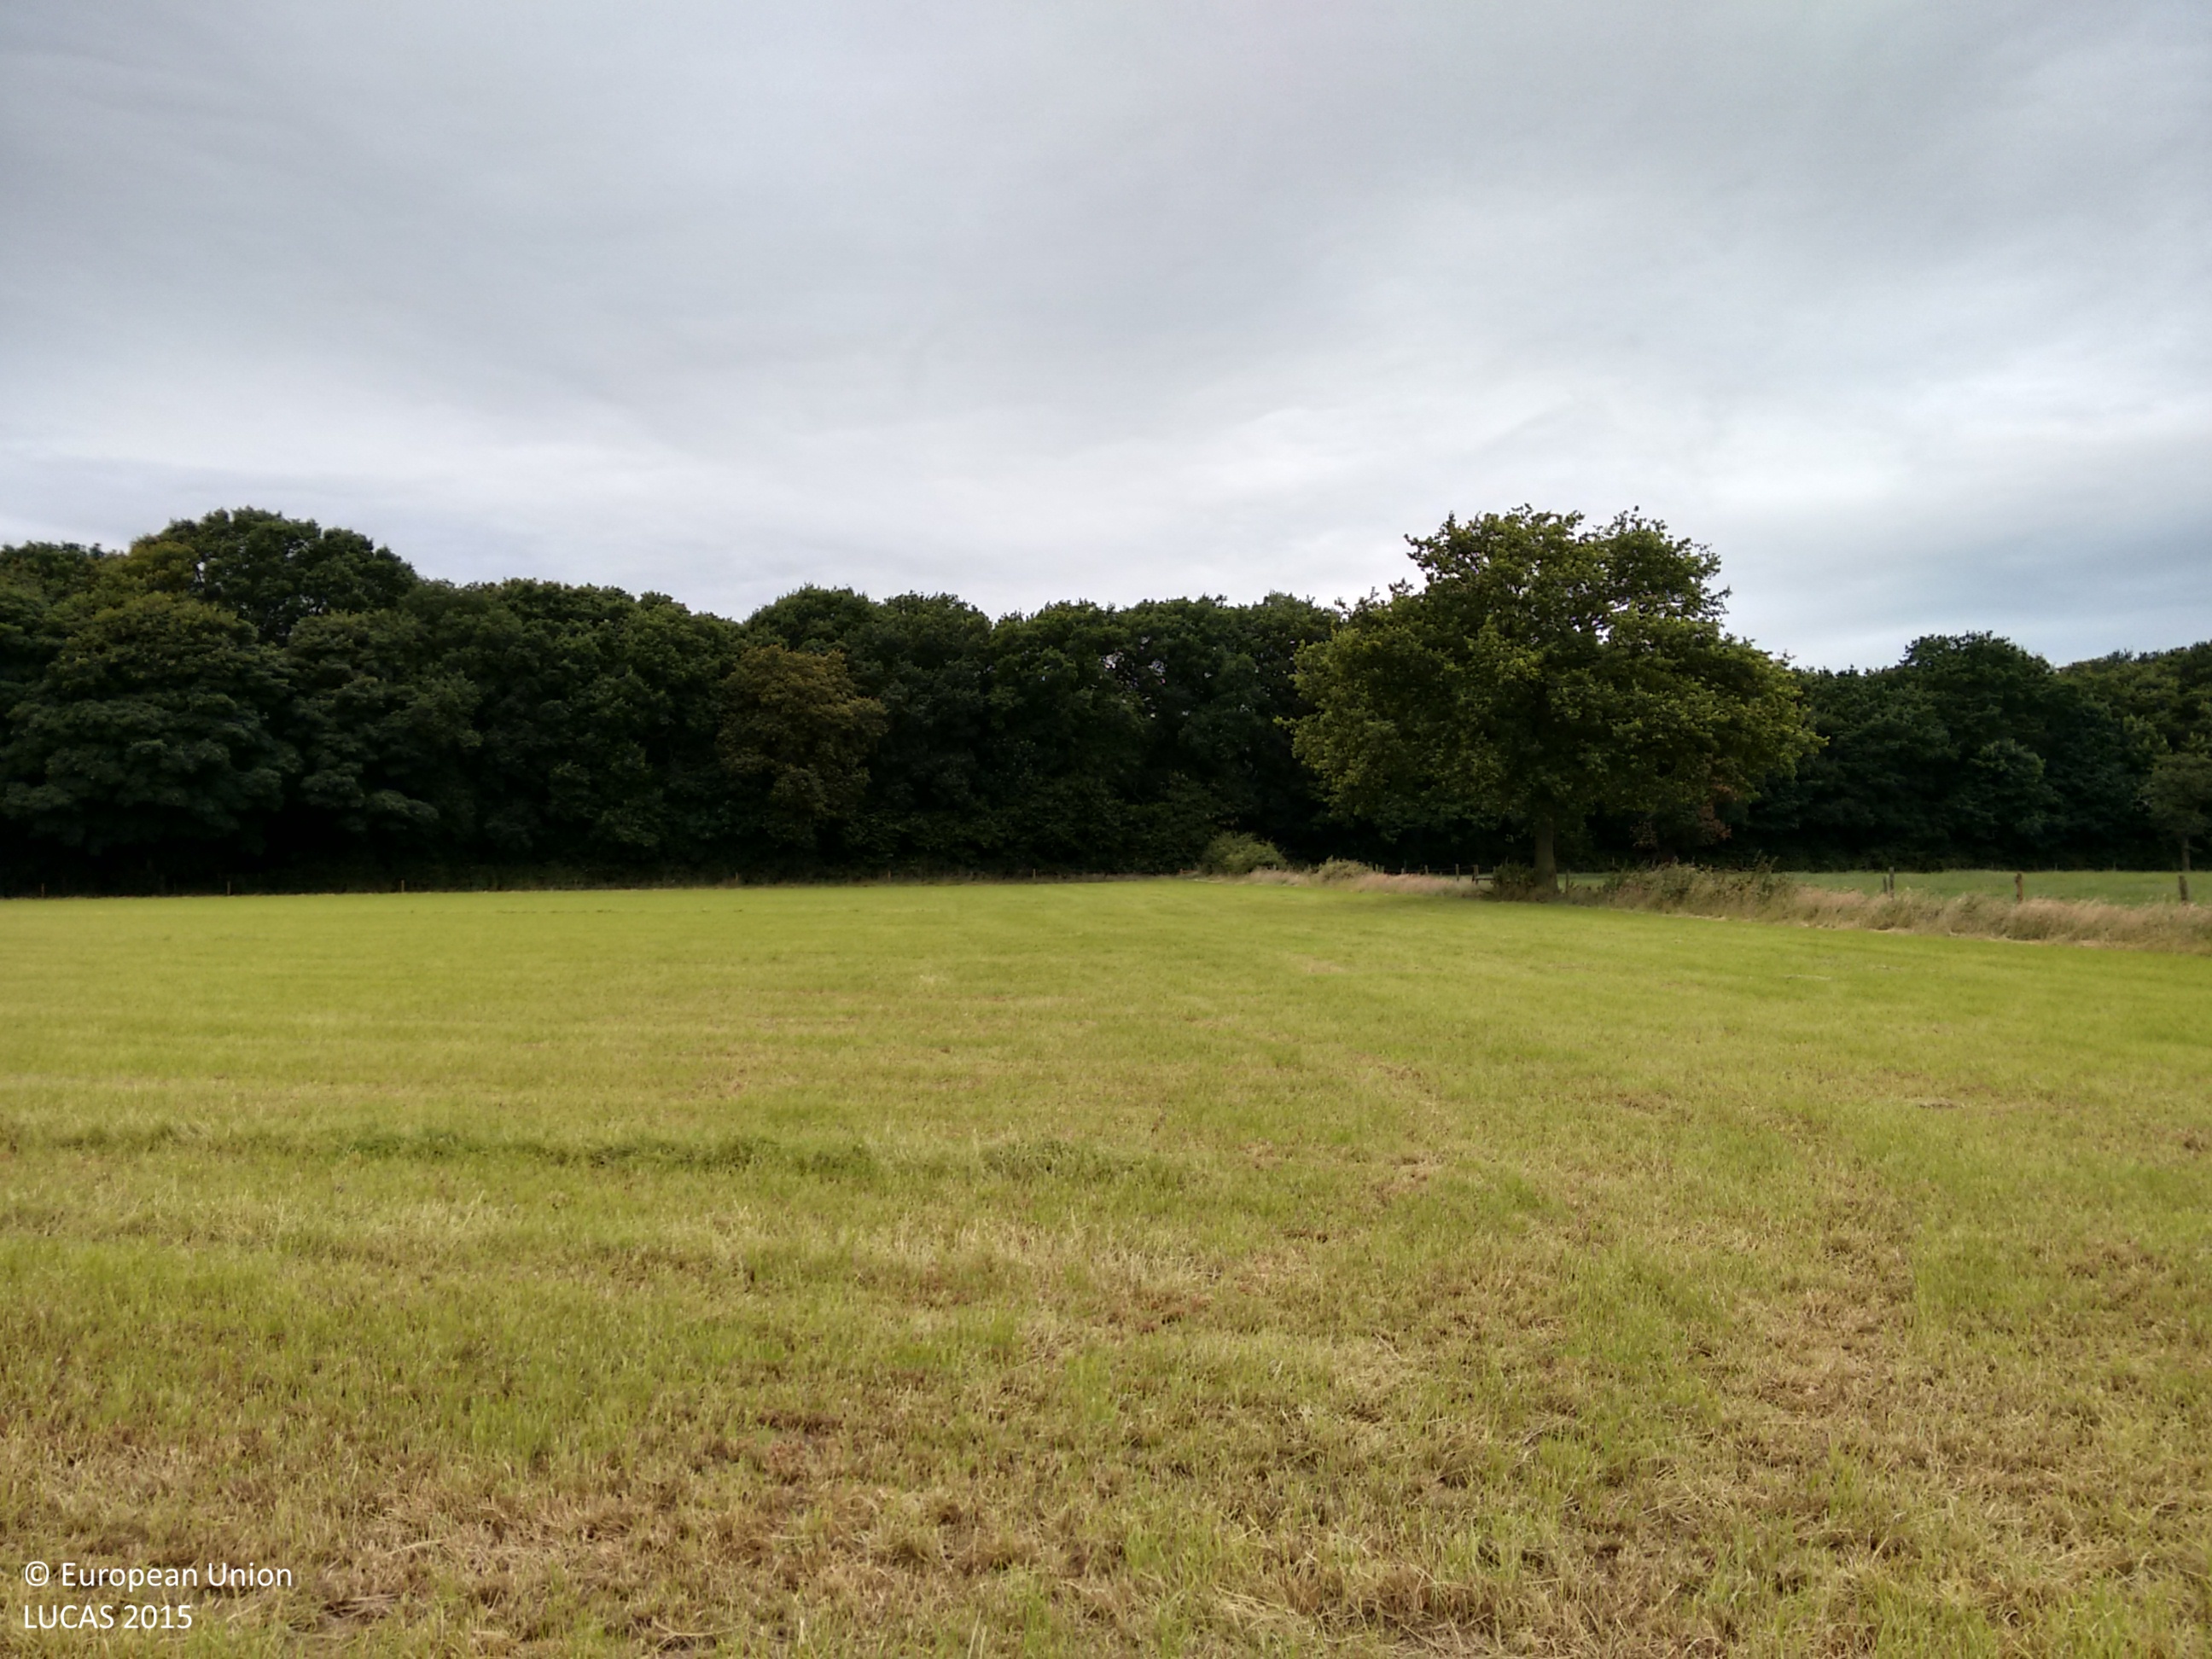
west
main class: Grassland
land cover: Grassland without tree/shrub cover
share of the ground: > 75 %
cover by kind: herbaceous plants 100 %
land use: Agriculture (excluding fallow land and kitchen gardens)
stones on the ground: < 10 %
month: July
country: GB
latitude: 53.3175
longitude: -2.4794
